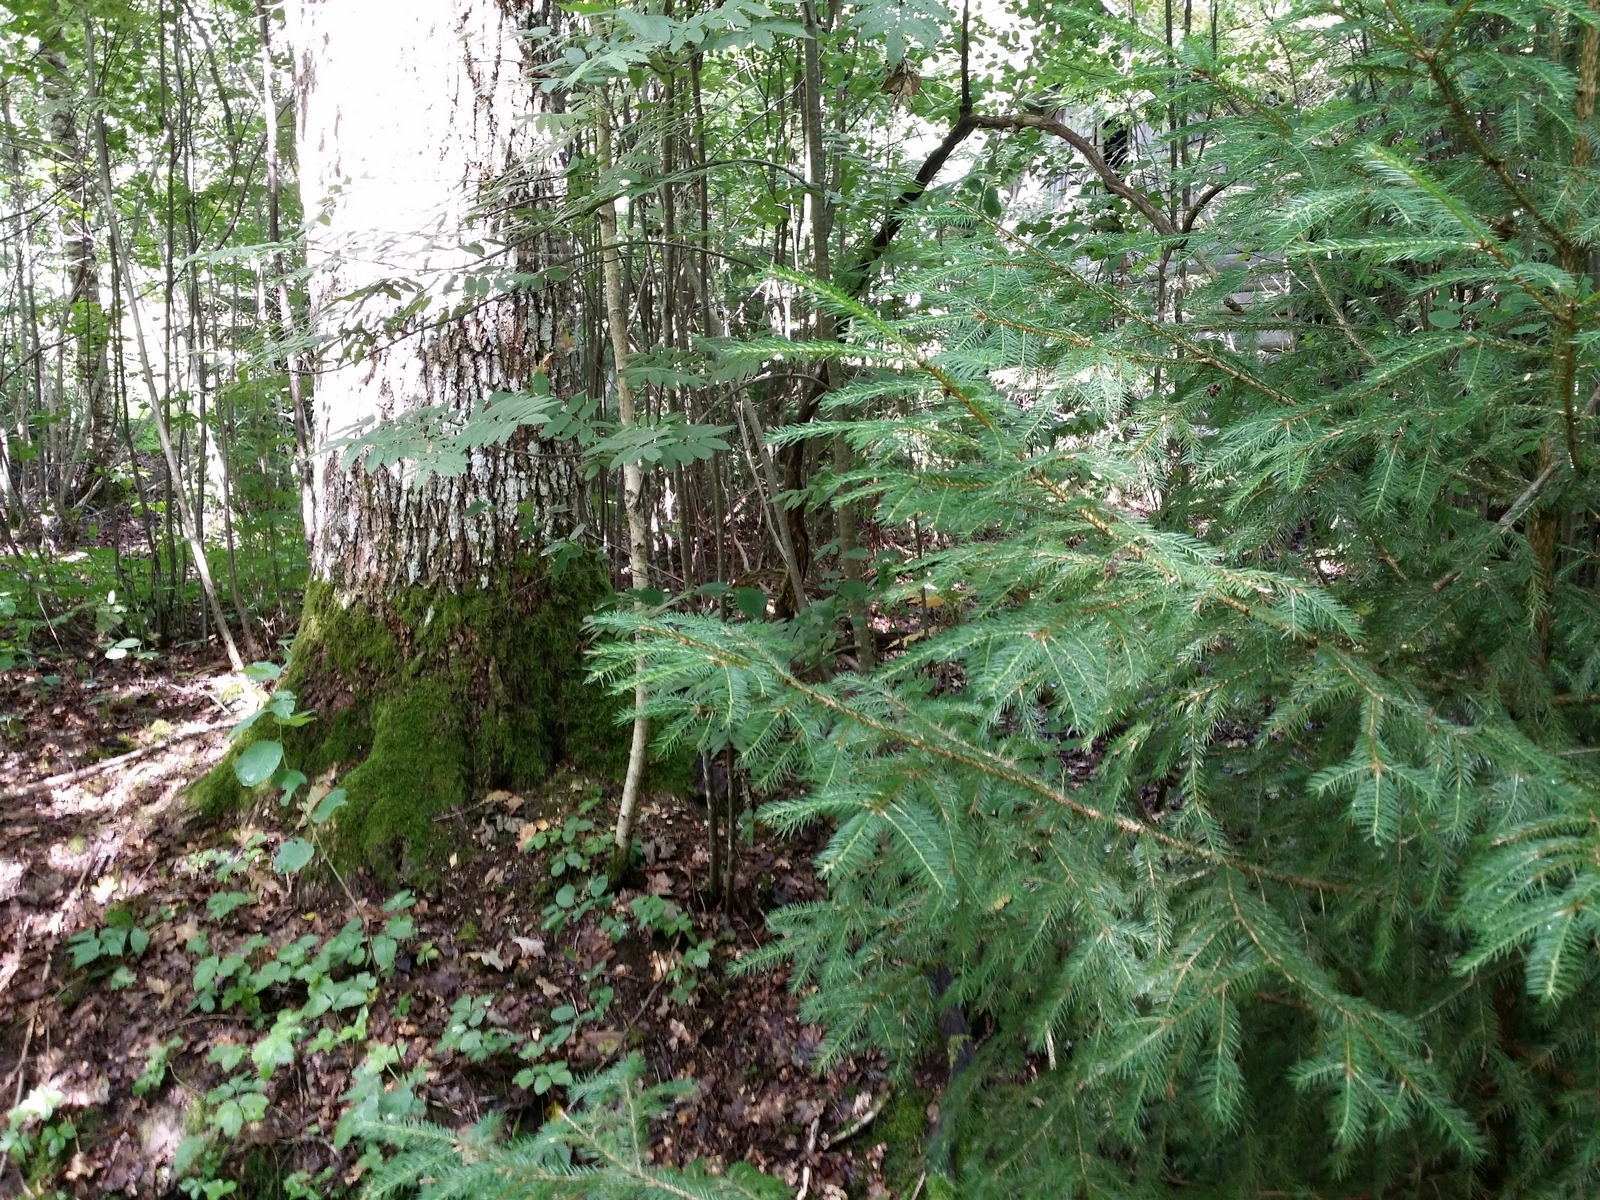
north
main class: Woodland
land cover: Spruce dominated mixed woodland
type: hemiboreal forest and nemoral coniferous forest and mixed broadleaved-coniferous forest
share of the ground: > 75 %
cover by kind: broadleaved forest trees 45 %, coniferous forest trees 40 %, herbaceous plants 10 %, unconsolidated bare surface 5 %
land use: Forestry
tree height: > 5 m
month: July
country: LV
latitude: 57.2470
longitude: 27.3223
